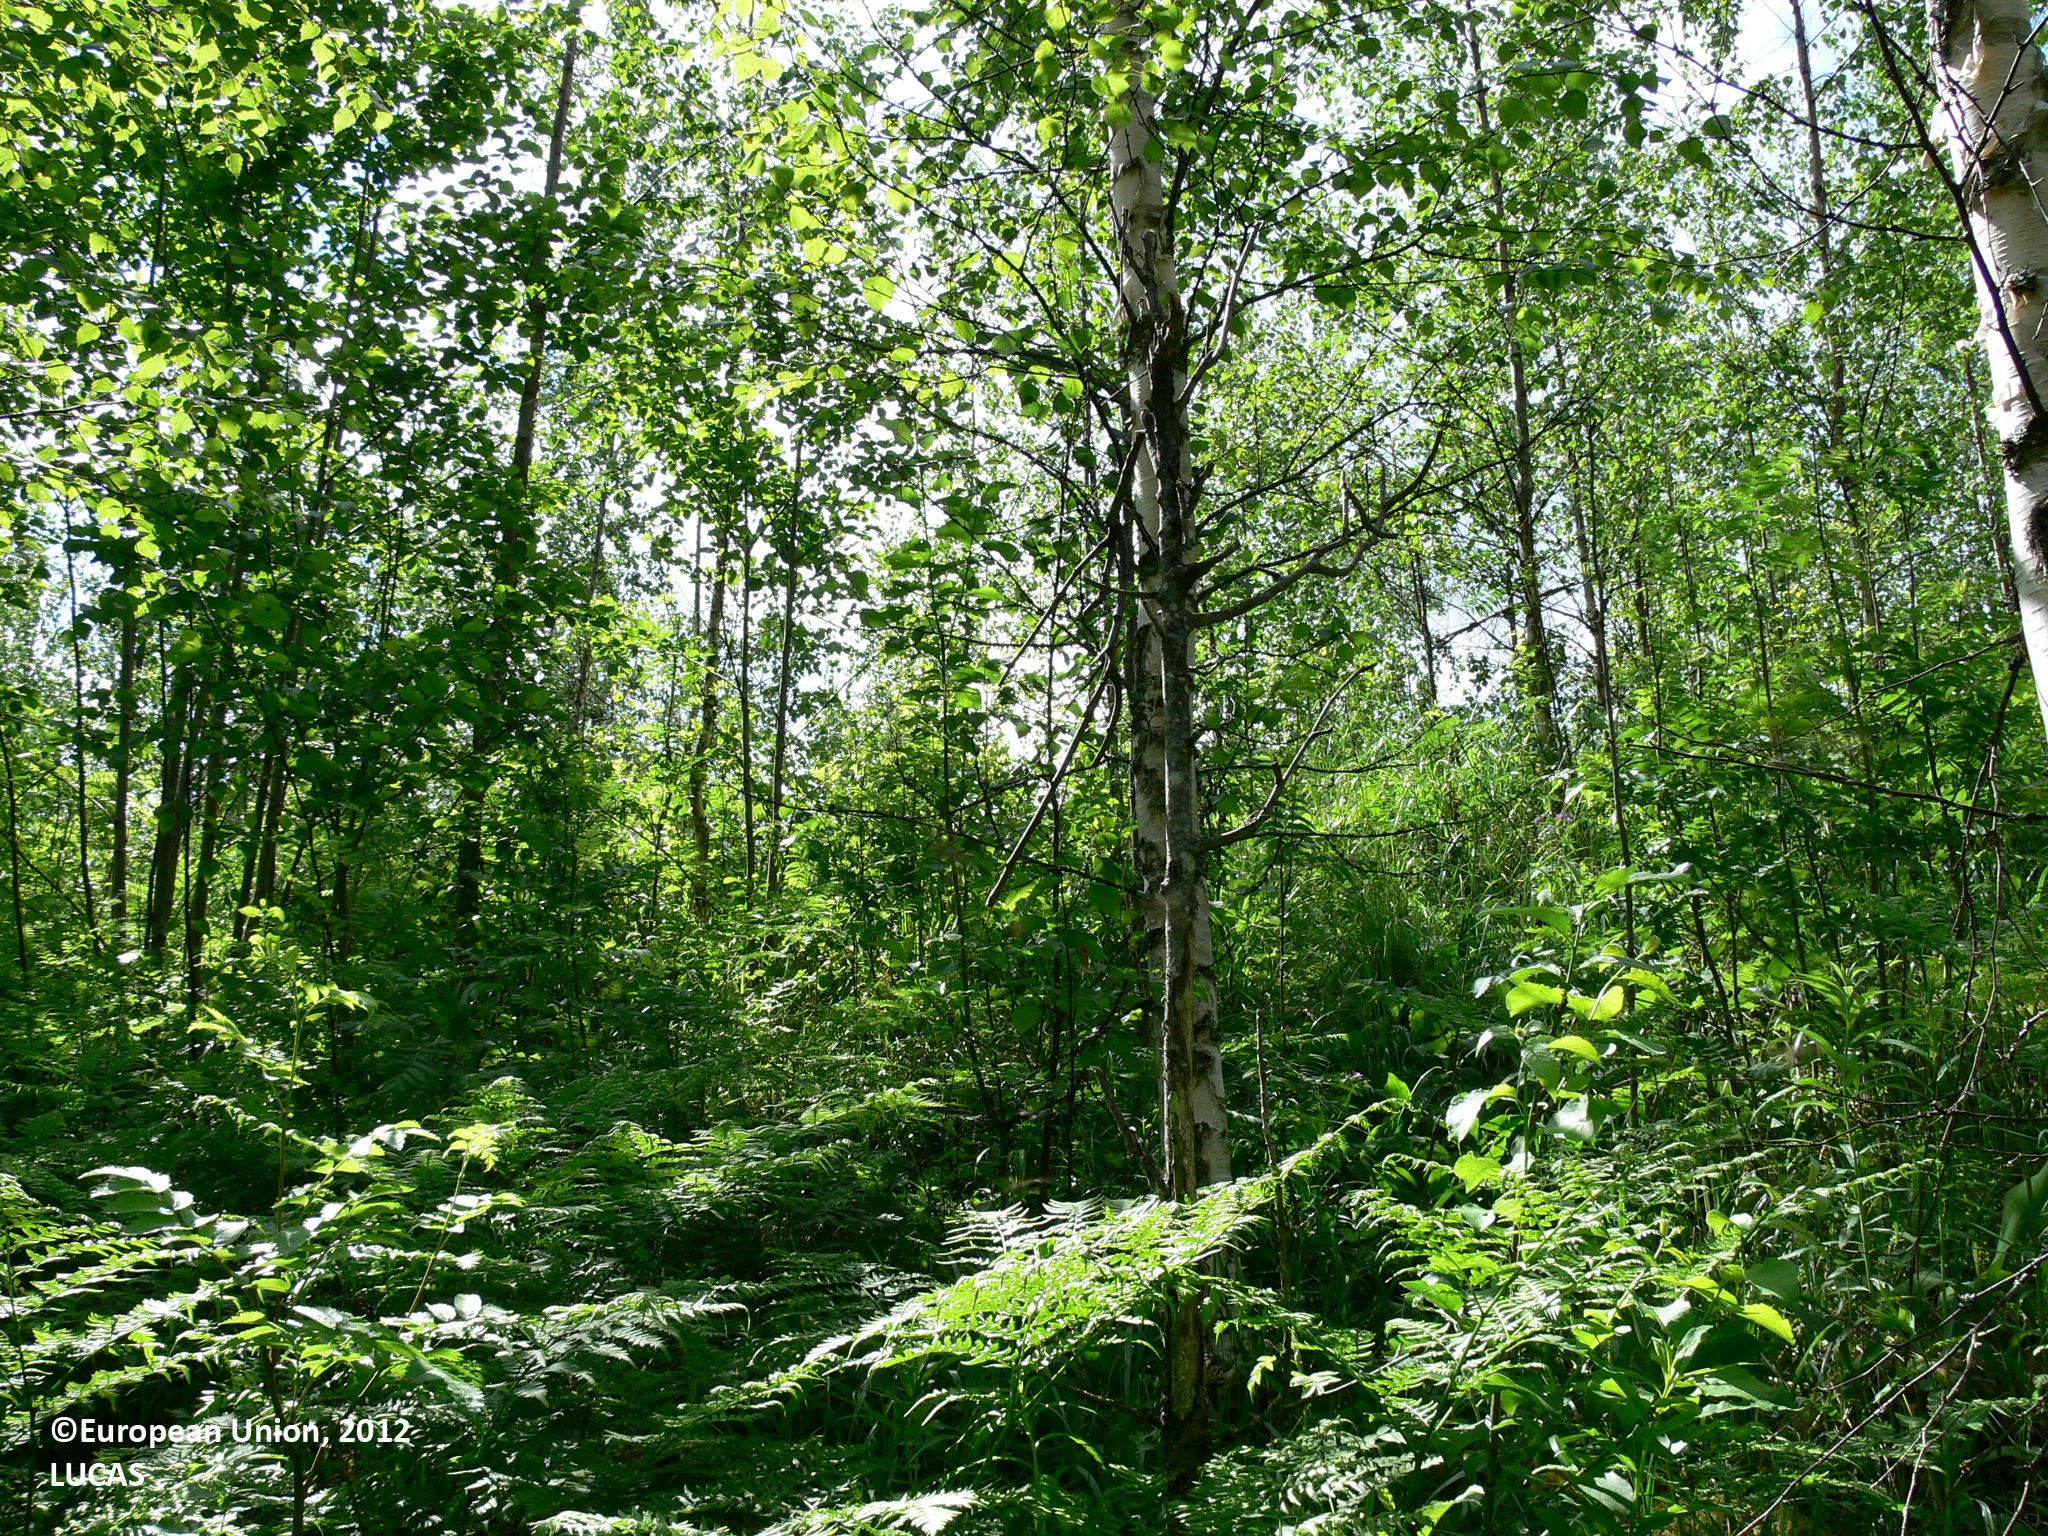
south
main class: Woodland
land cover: Broadleaved woodland
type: boreal forest
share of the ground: 50 - 75 %
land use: Forestry
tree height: > 5 m
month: June
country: FI
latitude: 62.3329
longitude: 30.1327
